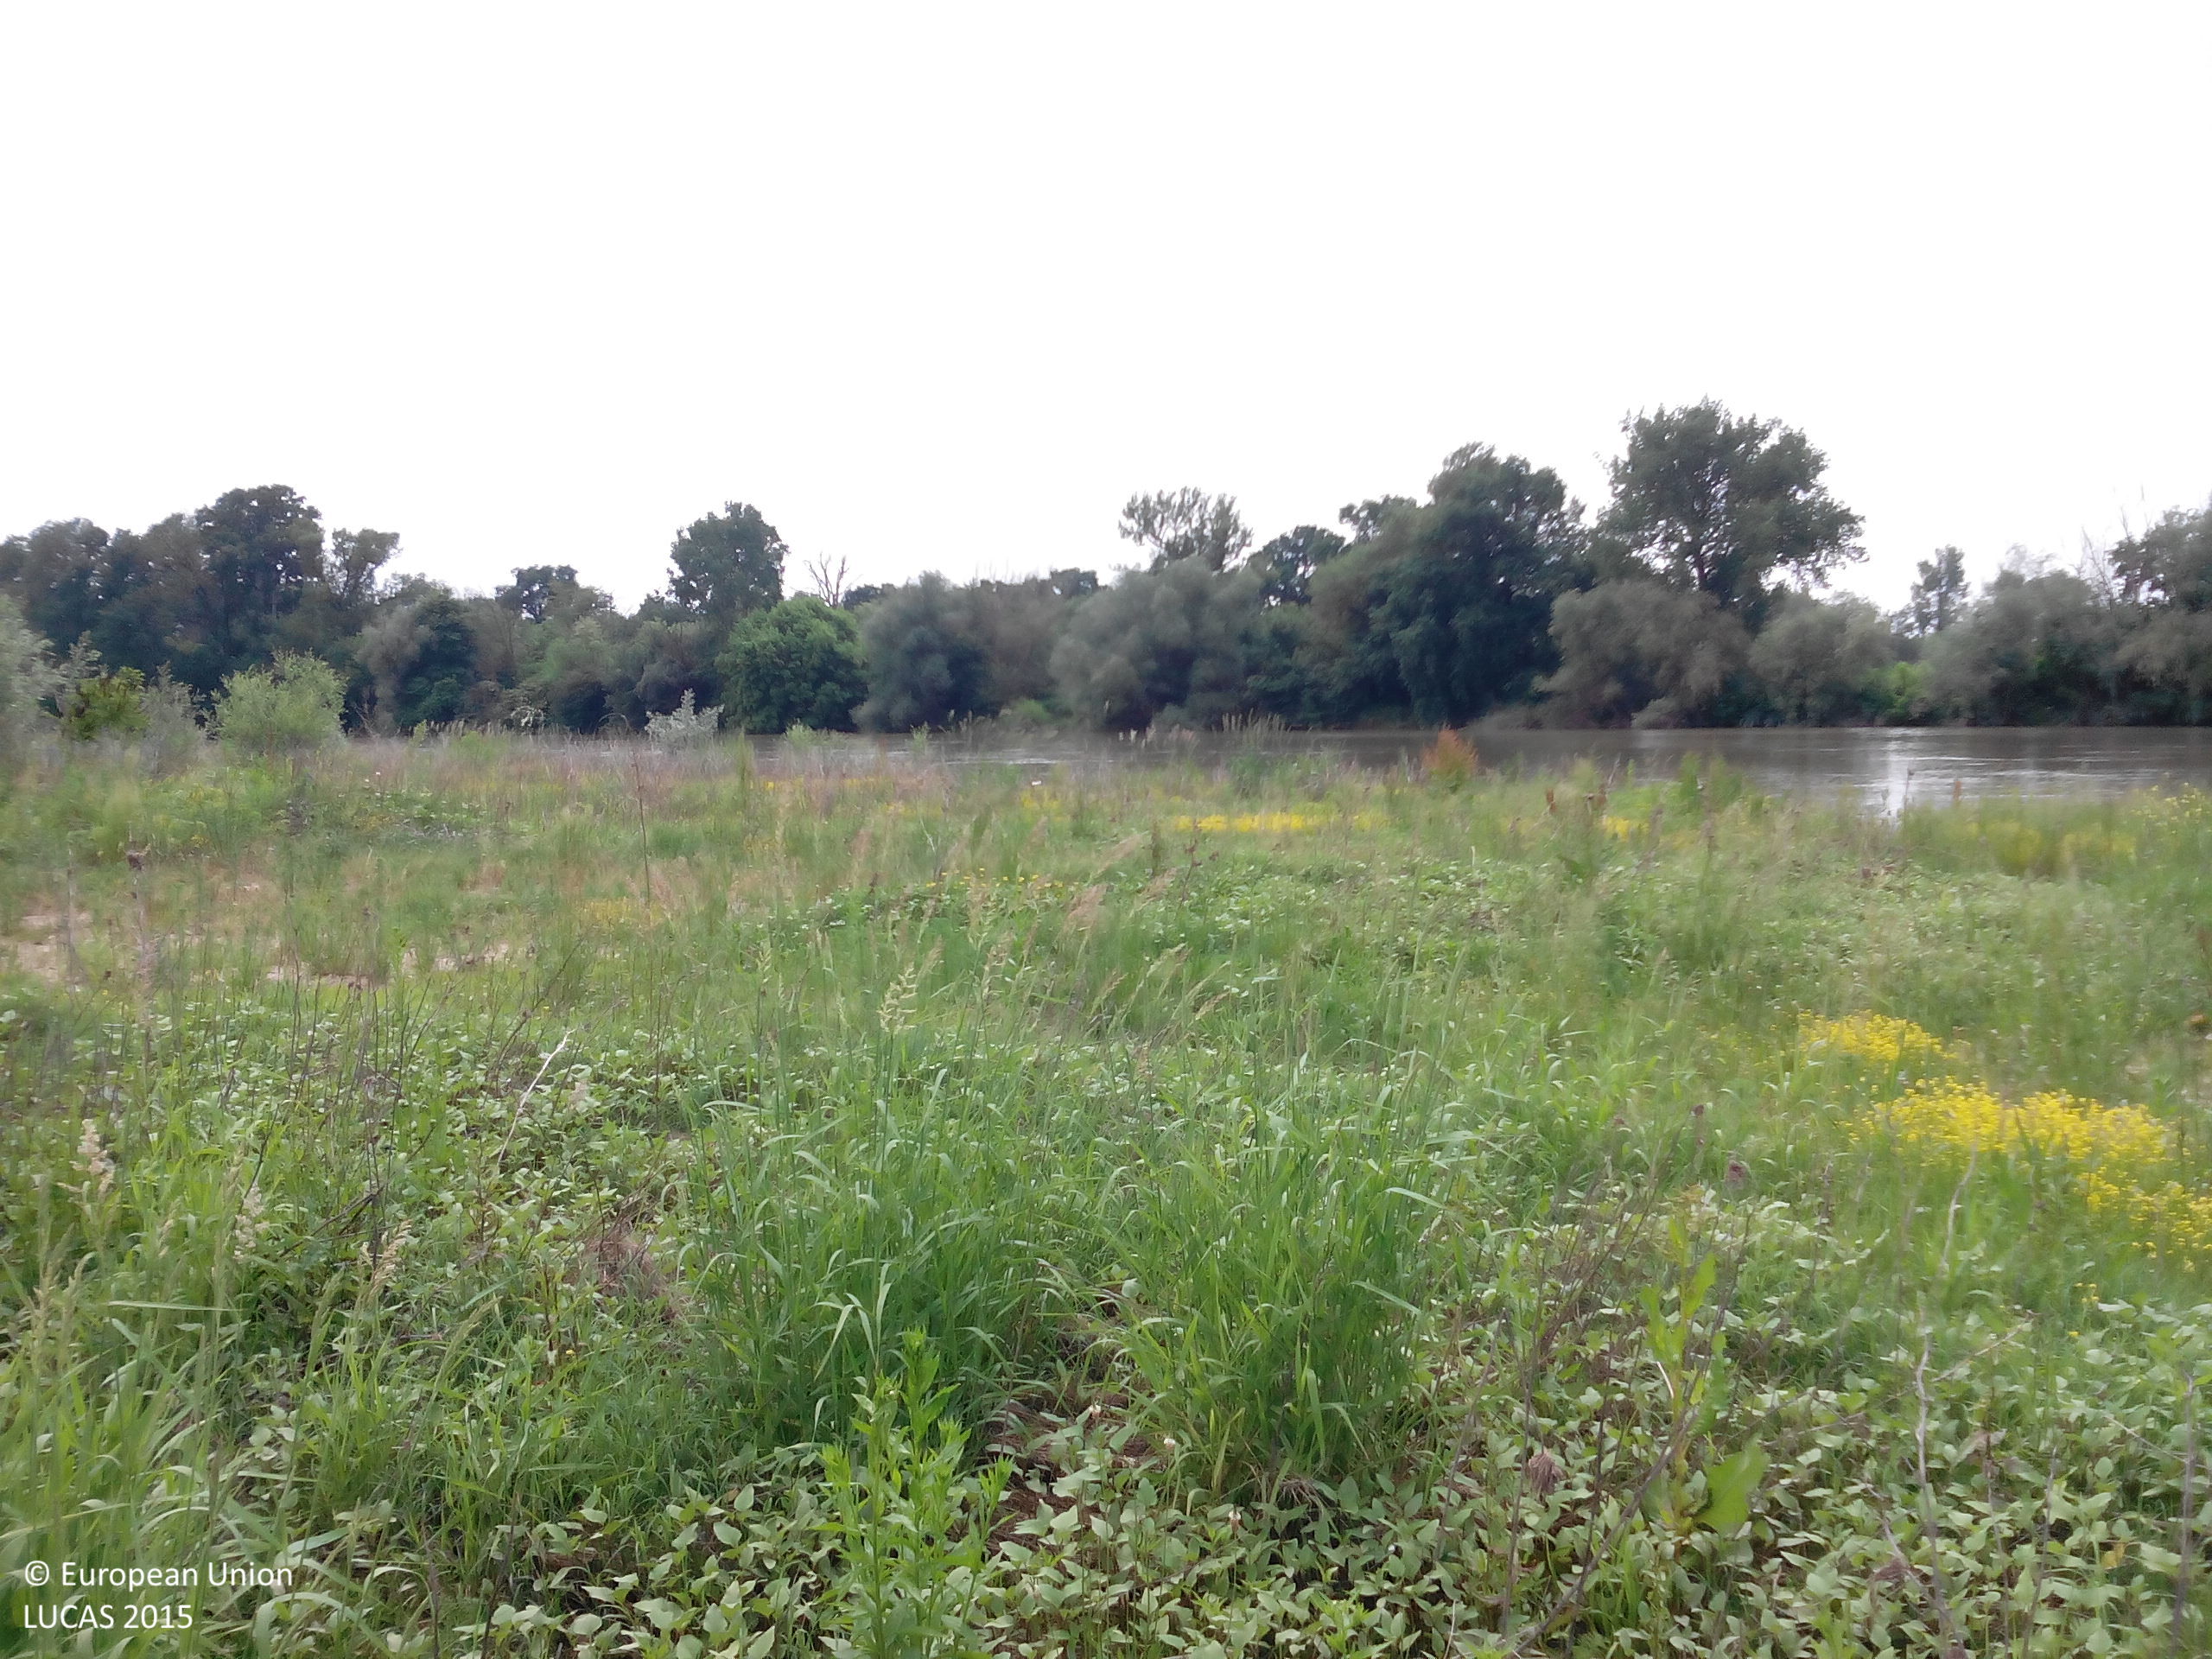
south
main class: Grassland
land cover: Grassland without tree/shrub cover
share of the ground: > 75 %
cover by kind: herbaceous plants 95 %, shrubs 5 %
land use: Agriculture (excluding fallow land and kitchen gardens)
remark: Temporary dry
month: May
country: BG
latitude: 43.4907
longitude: 24.2402
